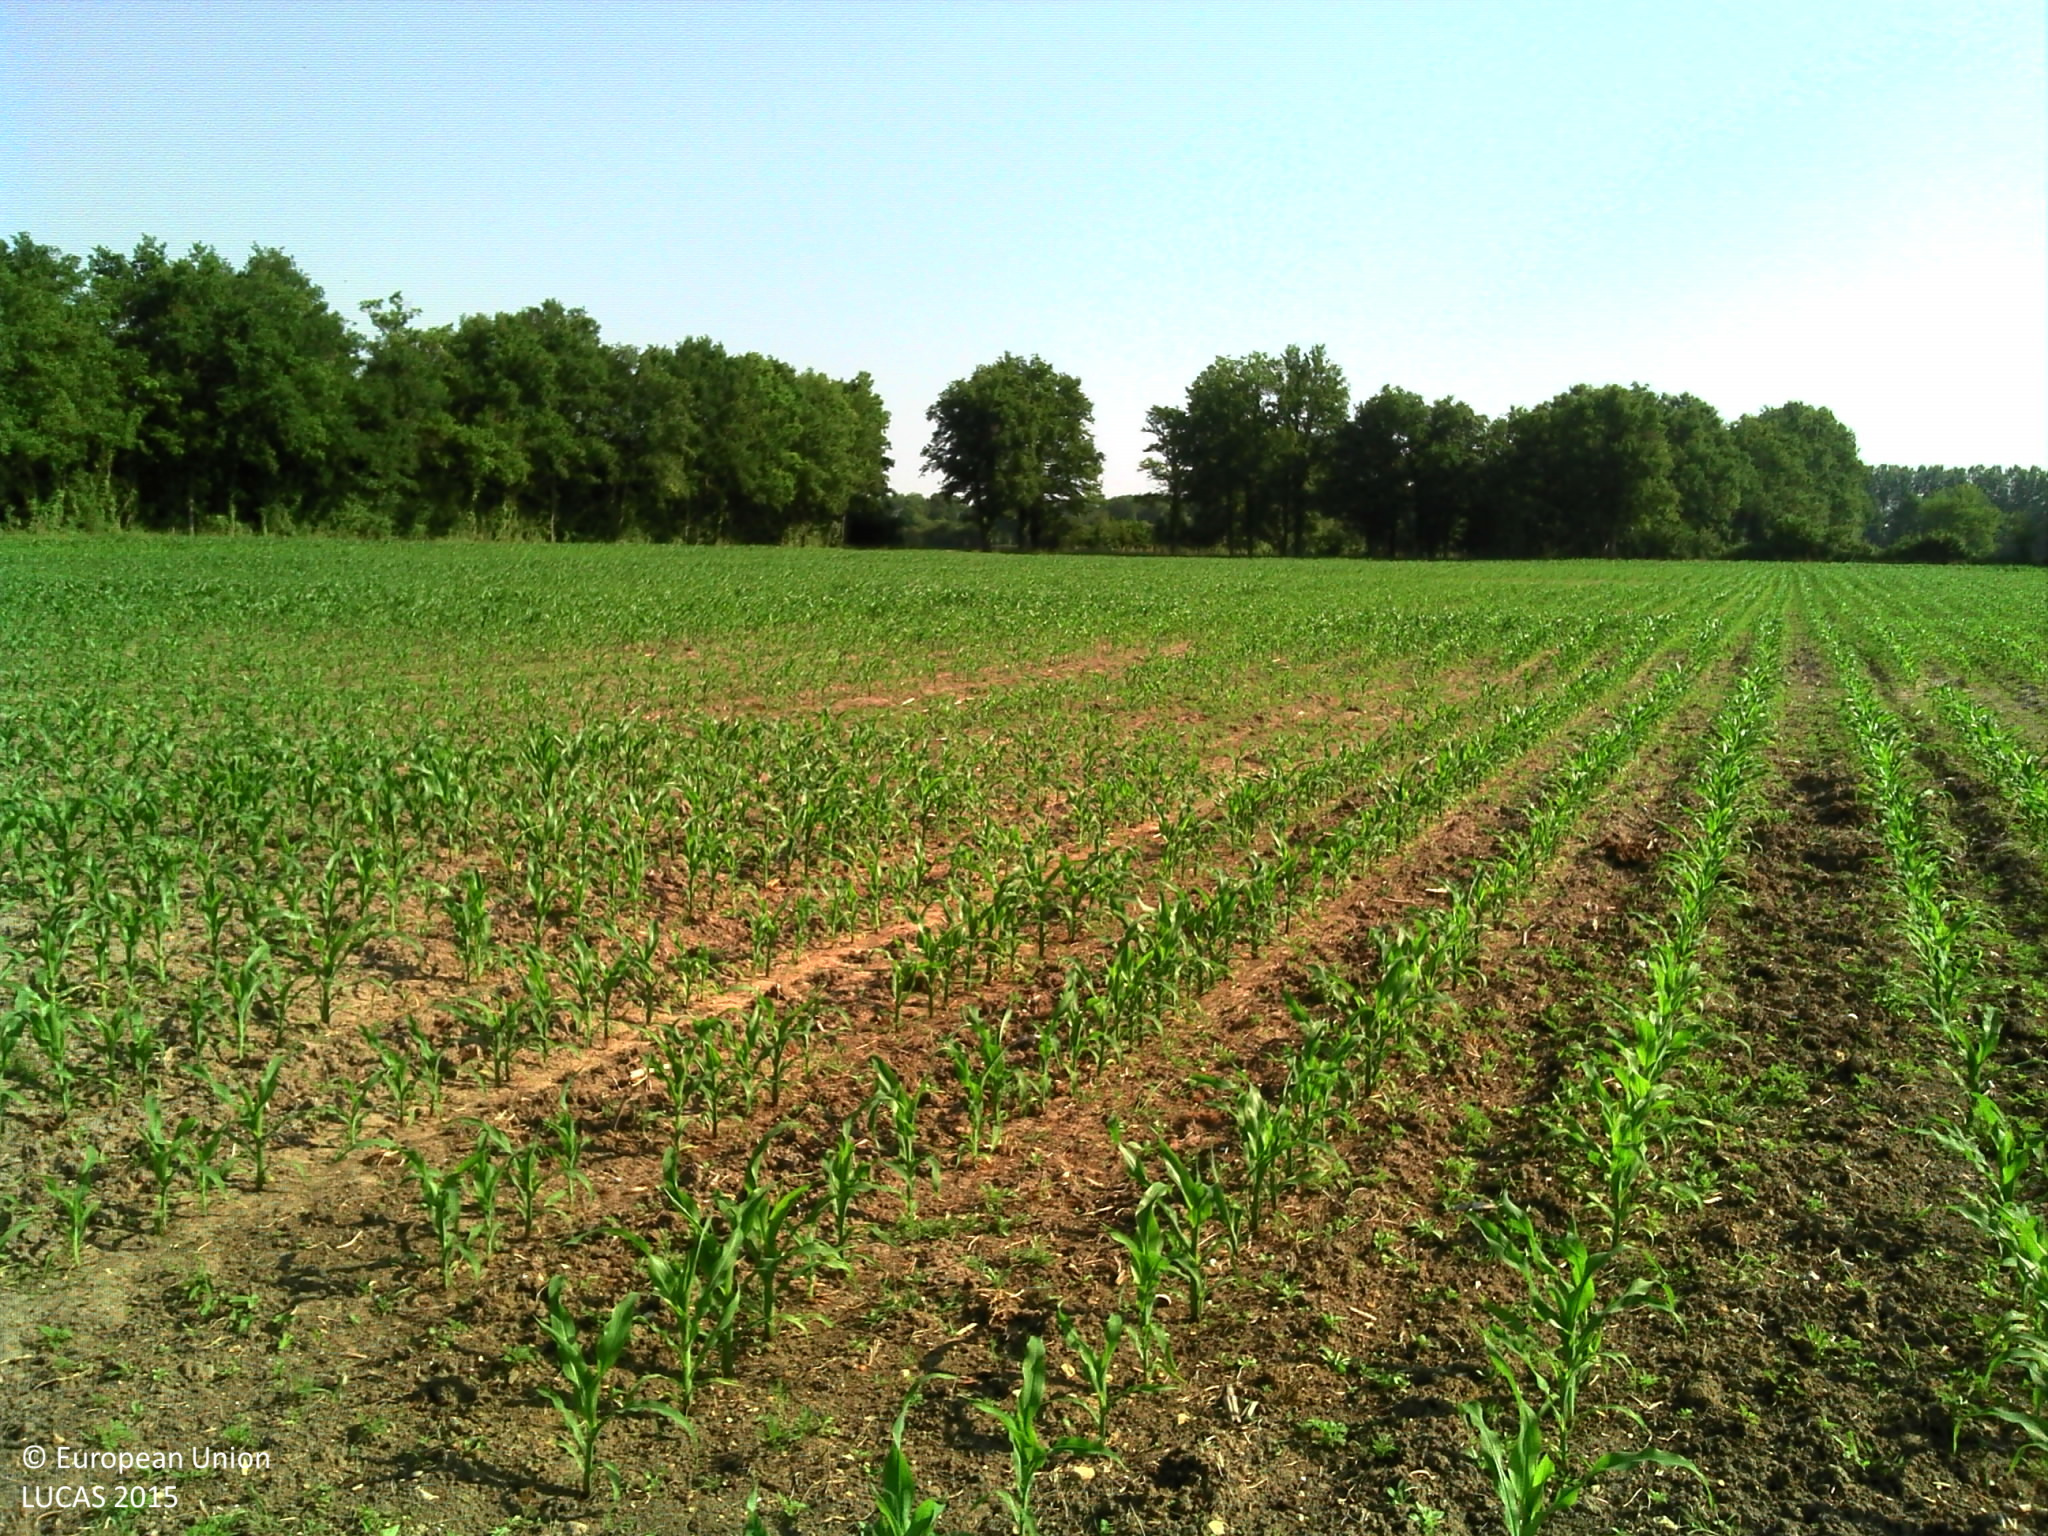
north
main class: Cropland
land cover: Maize
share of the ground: 50 - 75 %
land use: Agriculture (excluding fallow land and kitchen gardens)
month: June
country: FR
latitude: 46.7724
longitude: 2.7271
